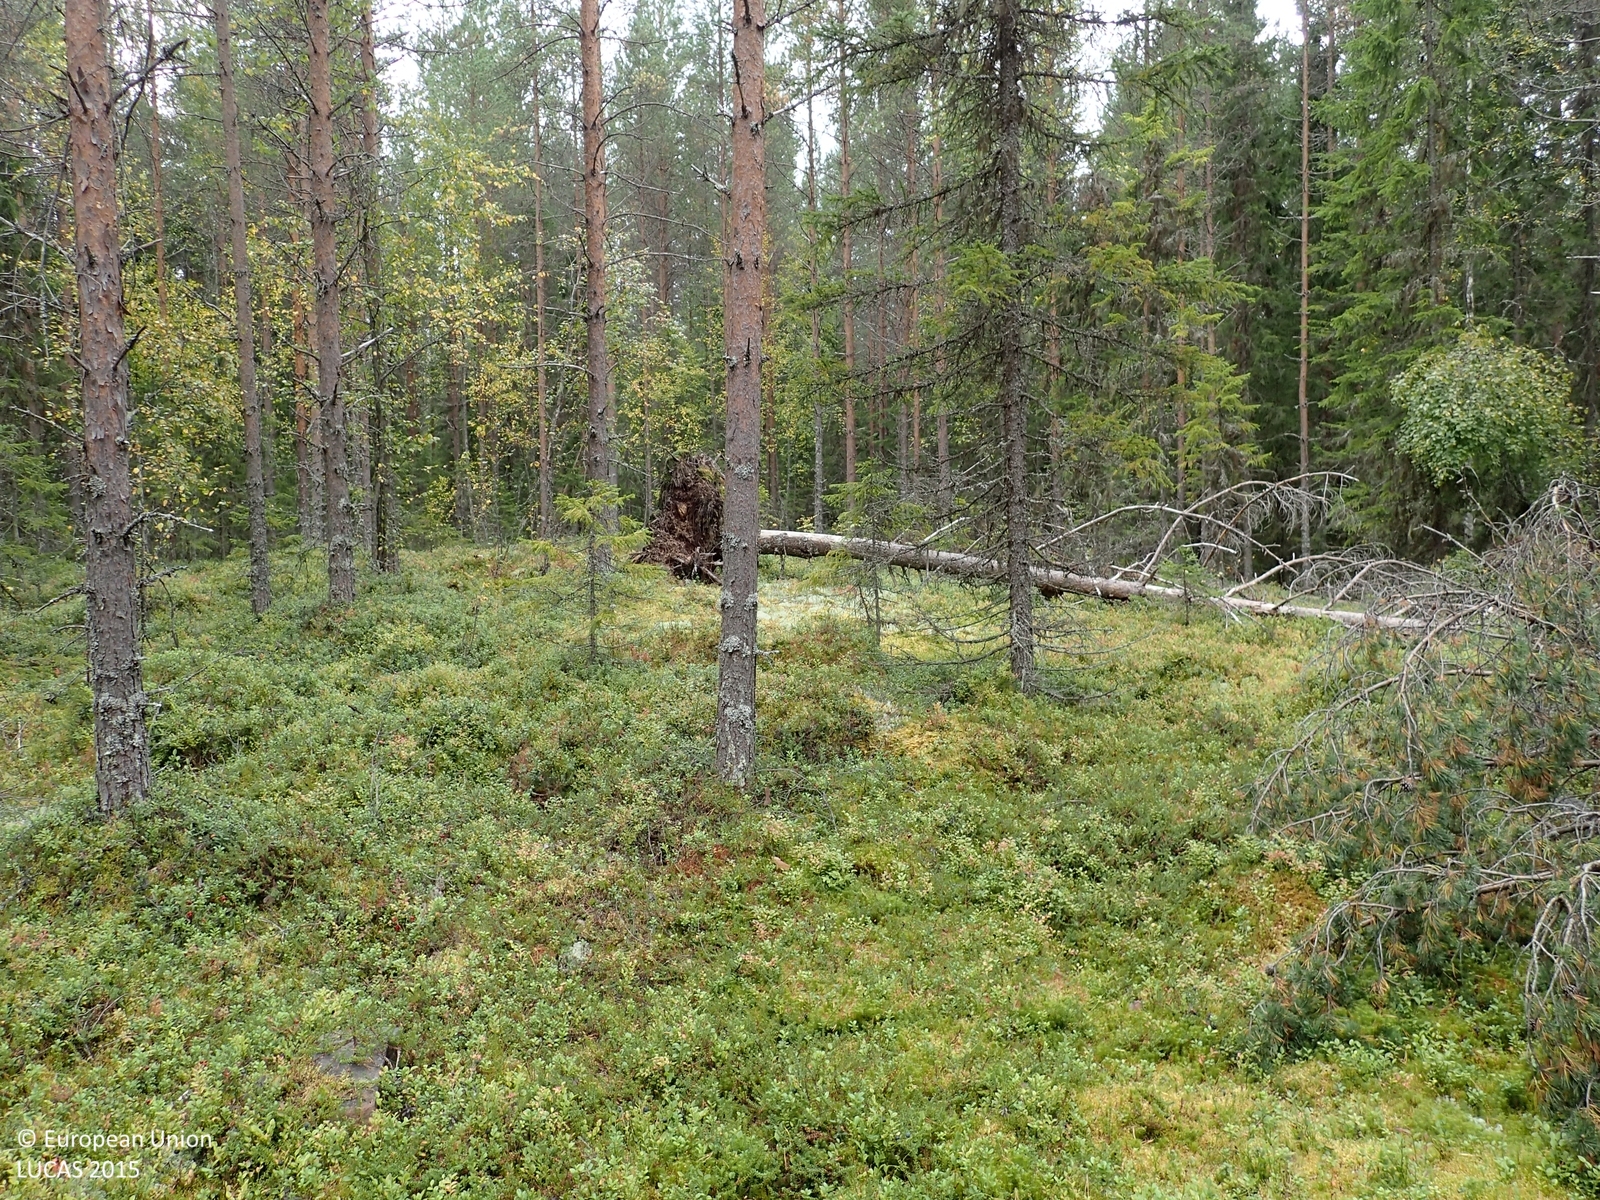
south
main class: Woodland
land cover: Other coniferous woodland
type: boreal forest
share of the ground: 50 - 75 %
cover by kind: coniferous forest trees 60 %, shrubs 25 %, broadleaved forest trees 10 %, lichens and mosses 5 %
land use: Forestry
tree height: > 5 m
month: September
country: FI
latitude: 62.9011
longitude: 25.7573
